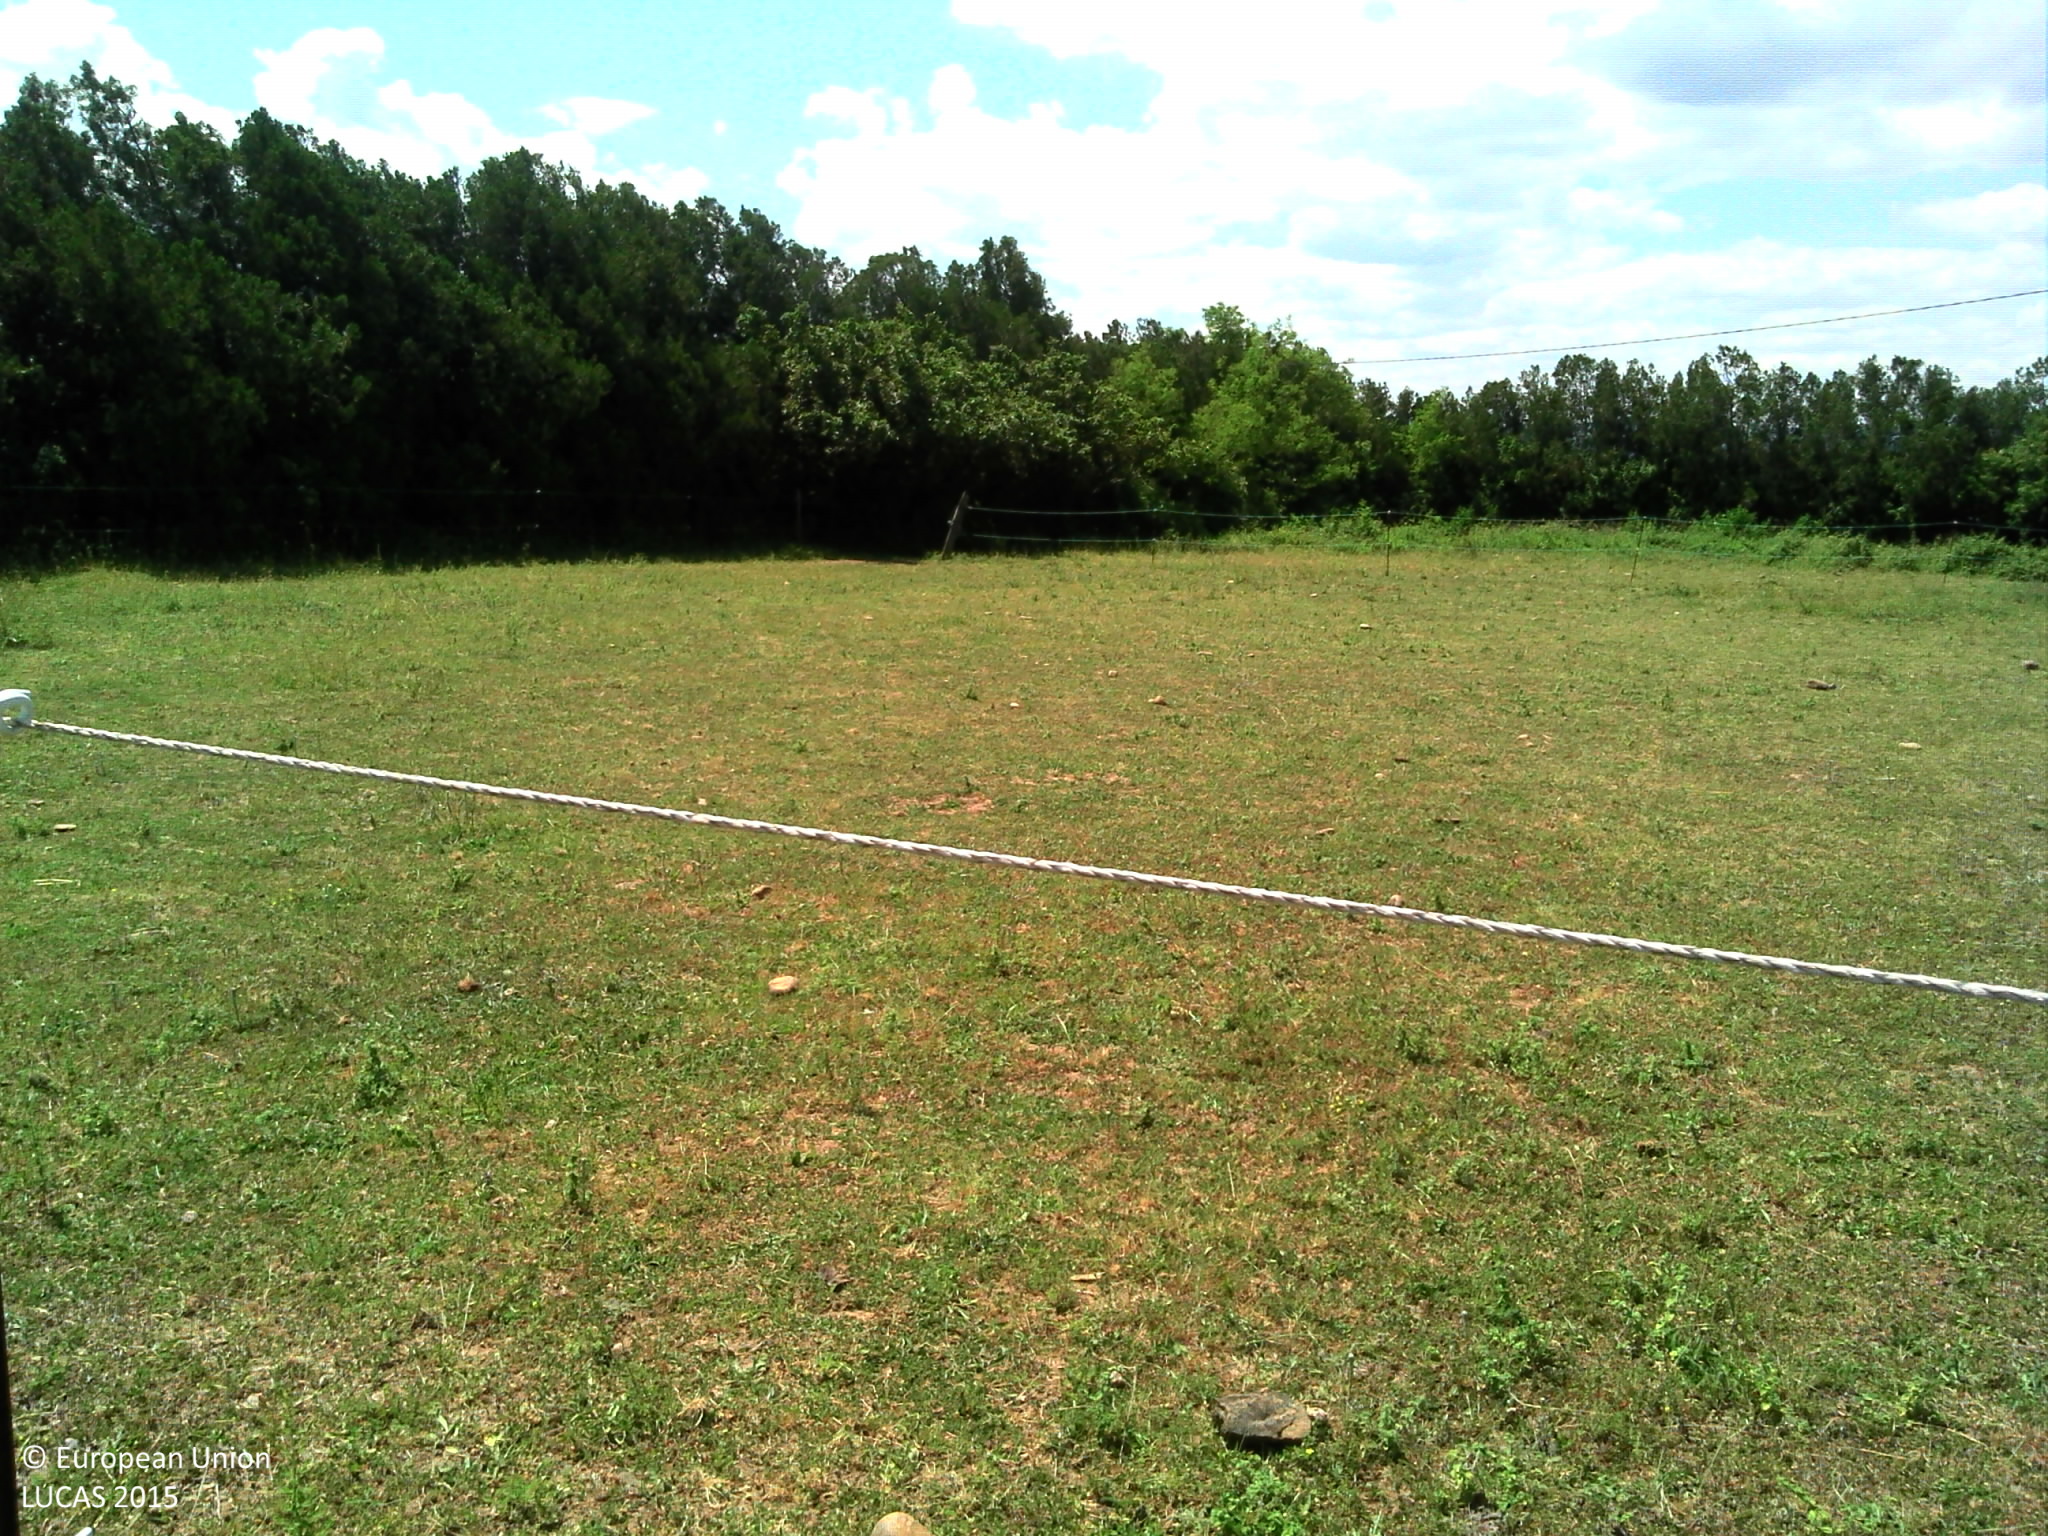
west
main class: Grassland
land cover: Grassland without tree/shrub cover
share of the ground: > 75 %
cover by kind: herbaceous plants 100 %
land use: Agriculture (excluding fallow land and kitchen gardens)
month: May
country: FR
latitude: 44.8770
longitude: 4.9297
